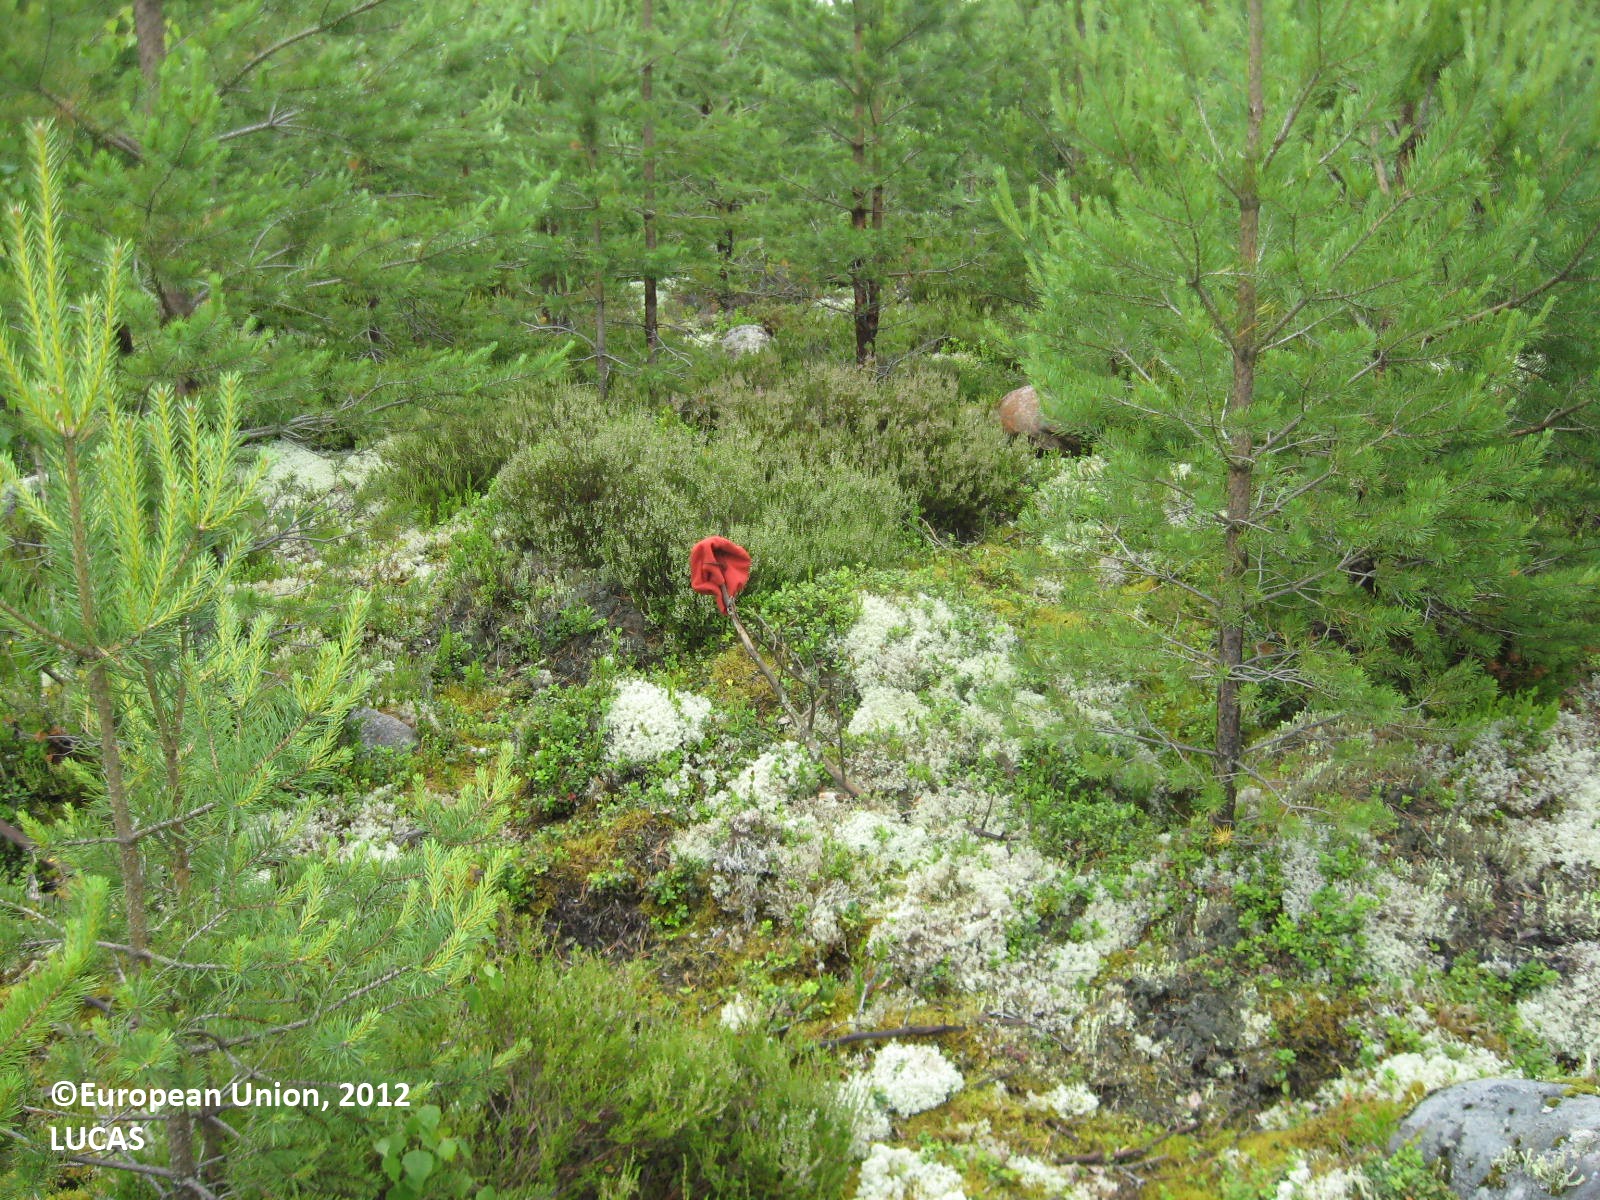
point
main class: Woodland
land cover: Pine dominated coniferous woodland
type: boreal forest
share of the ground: 50 - 75 %
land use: Forestry
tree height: < 5 m
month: July
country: FI
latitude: 62.4566
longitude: 22.4812
